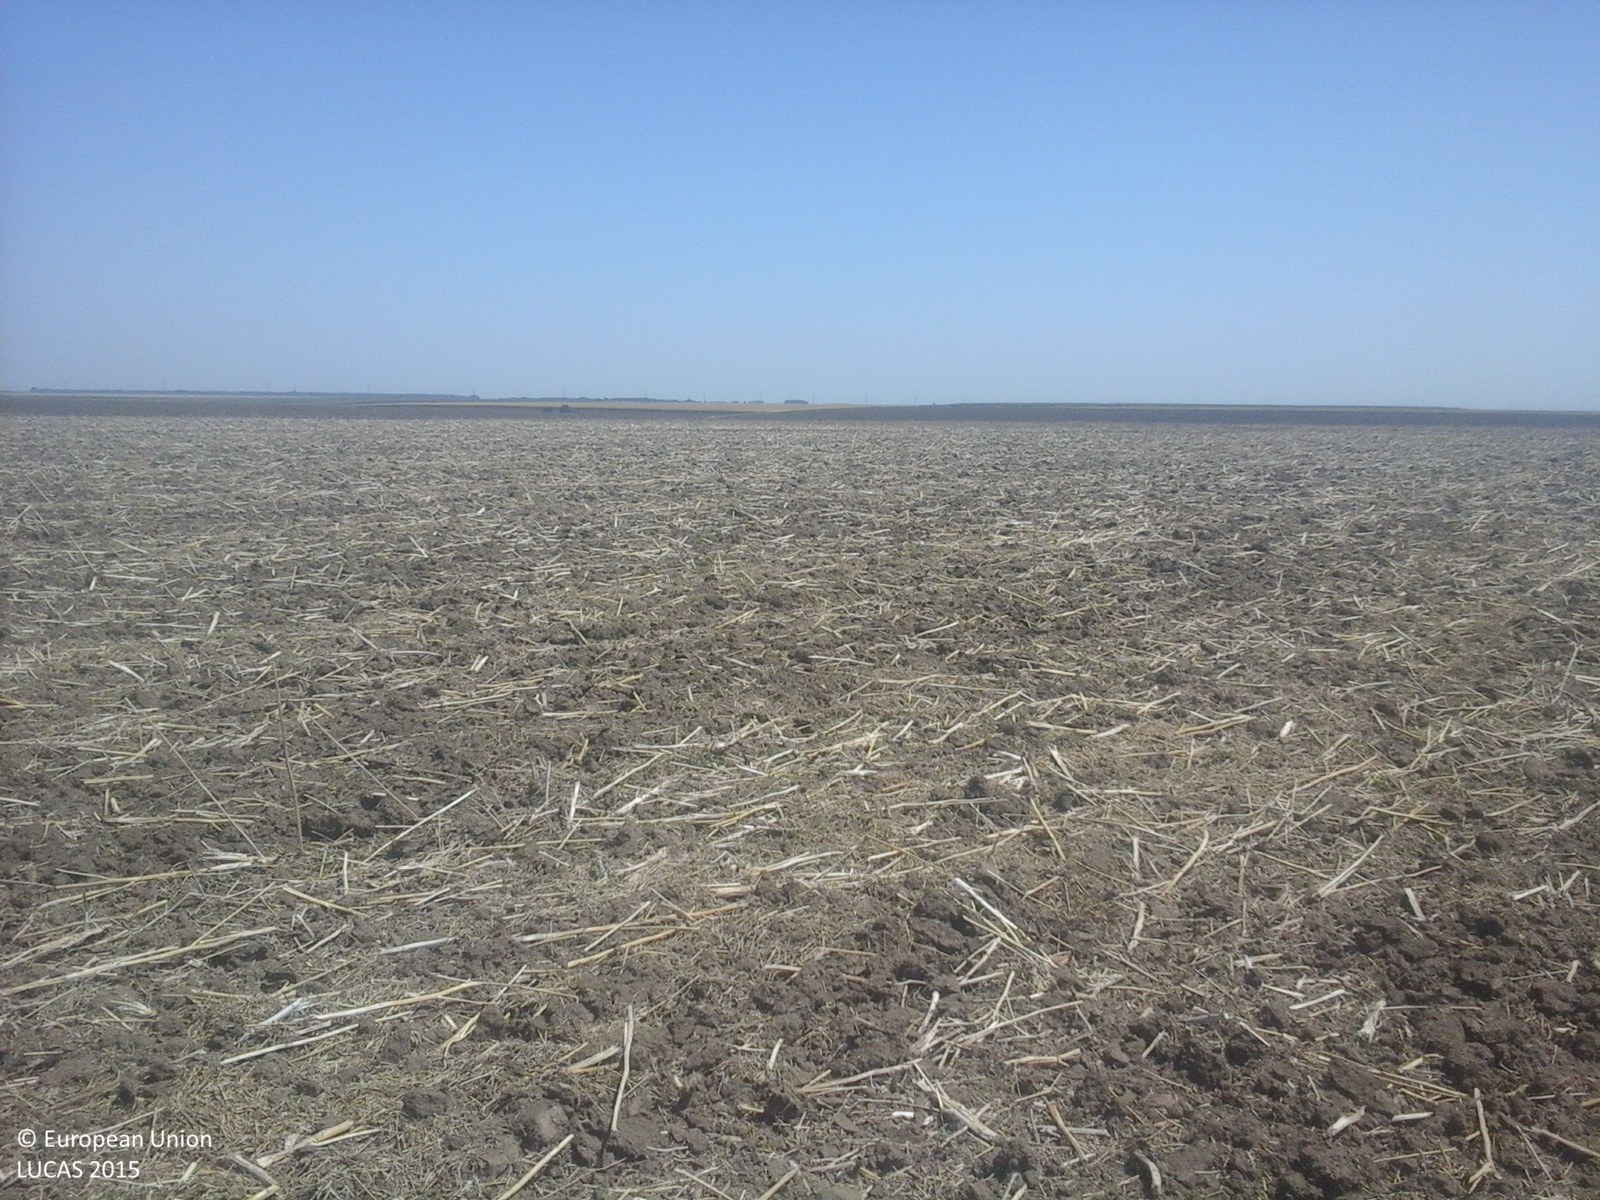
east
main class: Cropland
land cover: Rape and turnip rape
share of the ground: < 10 %
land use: Agriculture (excluding fallow land and kitchen gardens)
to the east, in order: Rape and turnip rape; Tracks; Common wheat
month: July
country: RO
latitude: 44.4139
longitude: 26.7358
